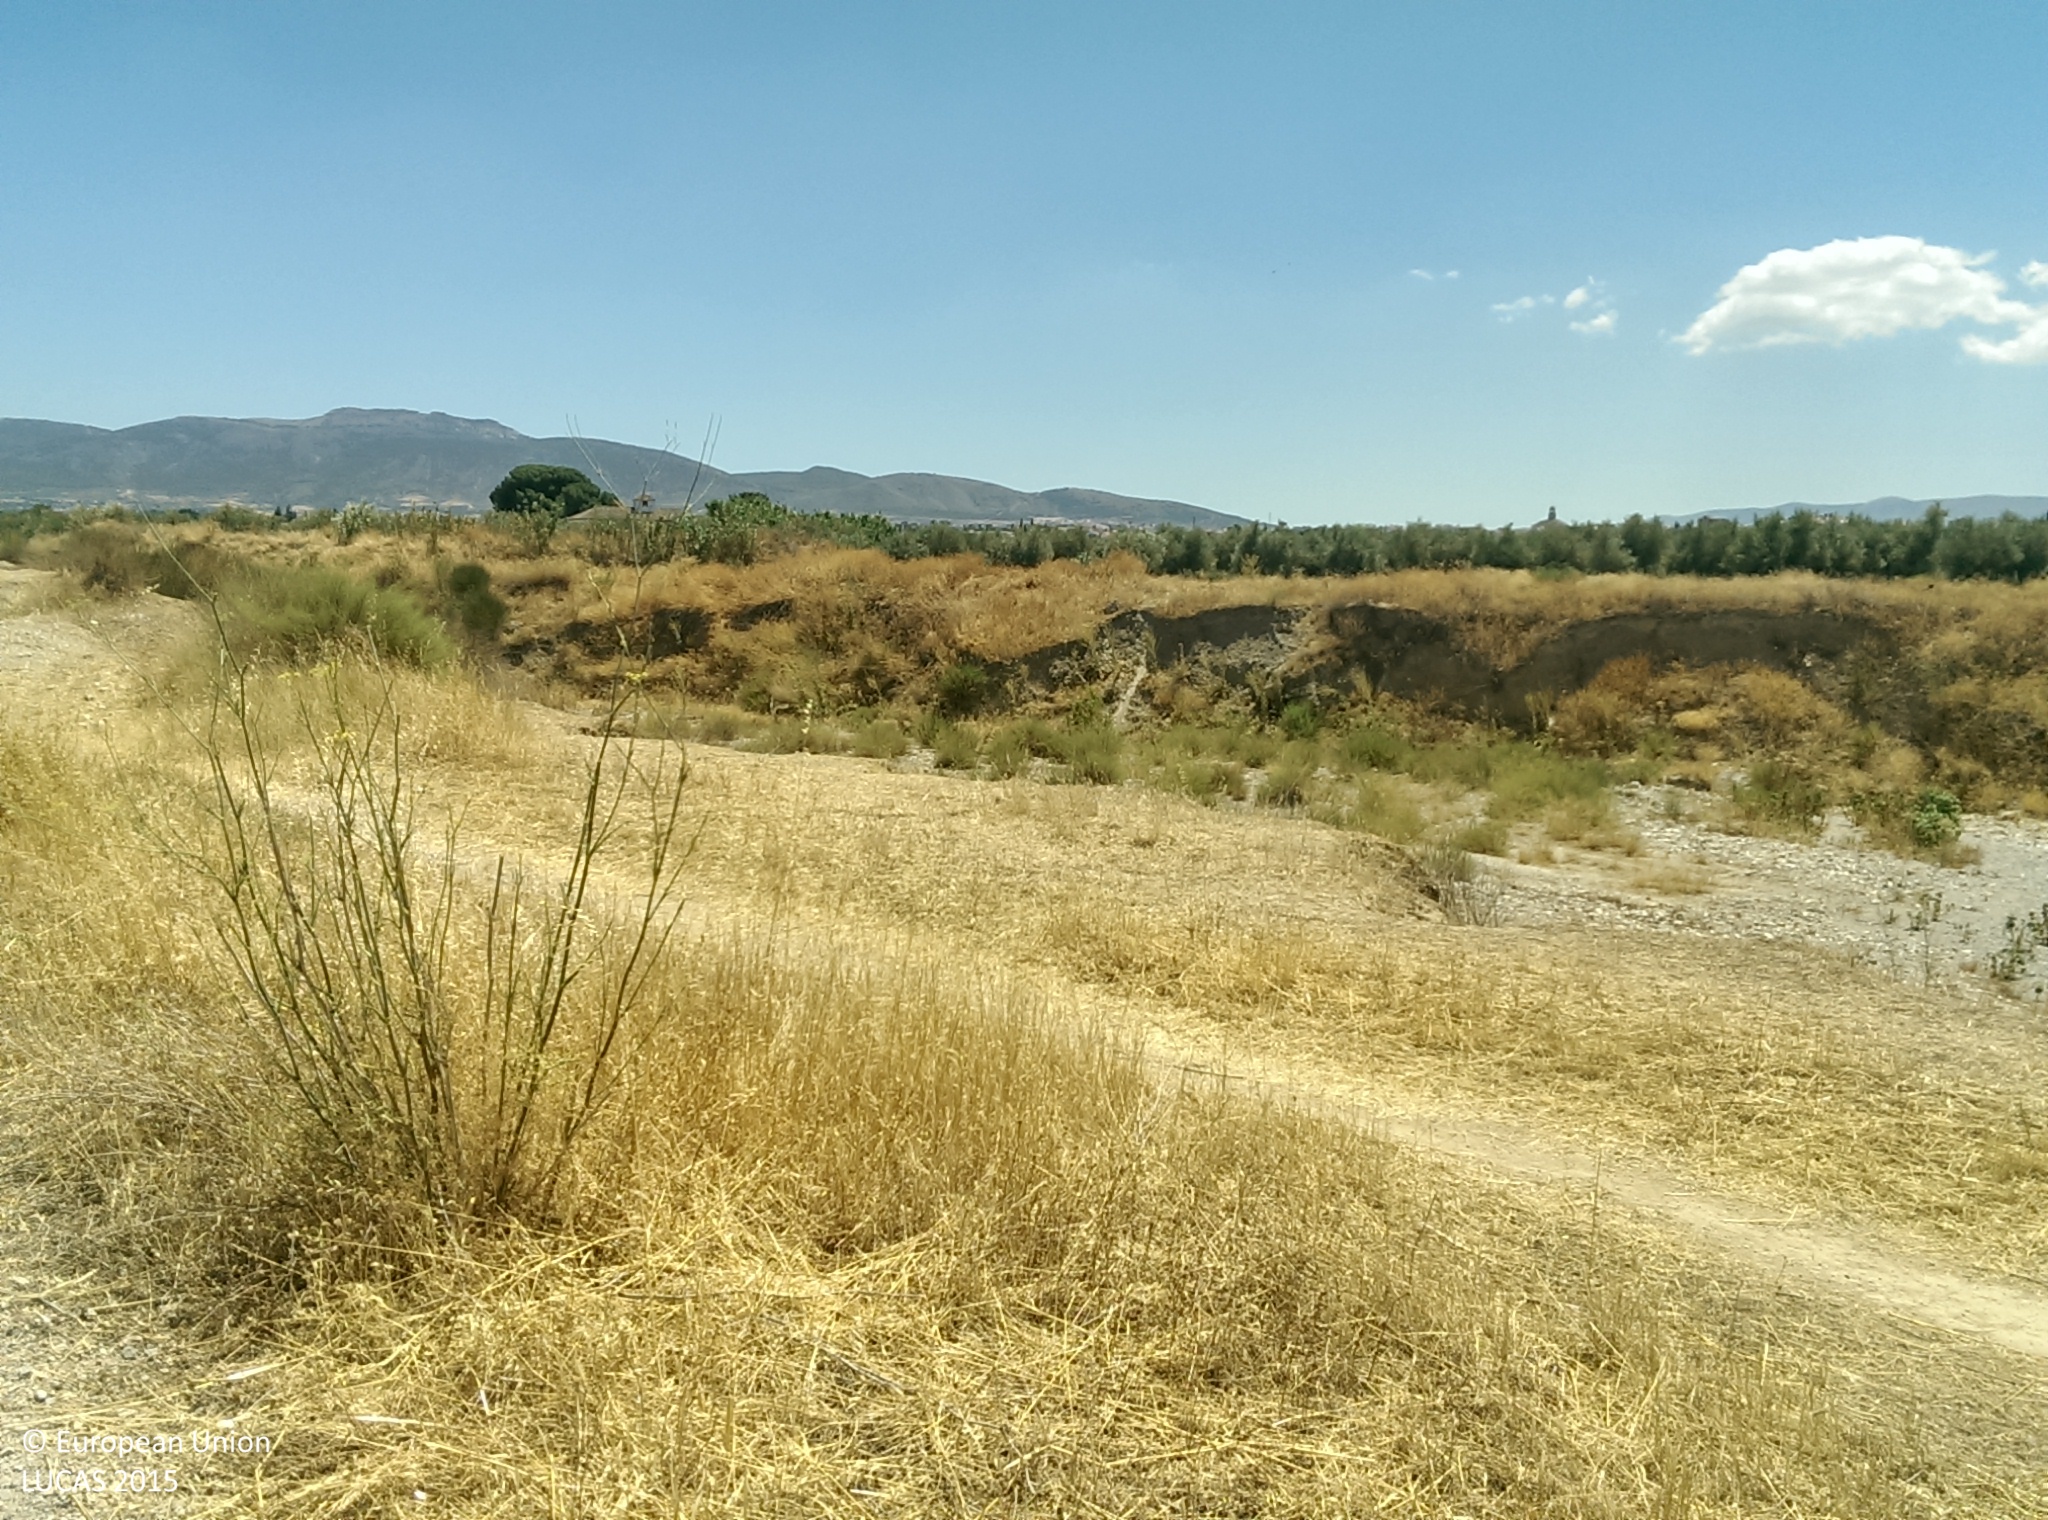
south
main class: Grassland
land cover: Grassland without tree/shrub cover
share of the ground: > 75 %
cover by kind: herbaceous plants 100 %
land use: Air transport
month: July
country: ES
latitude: 37.1267
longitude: -3.6420
